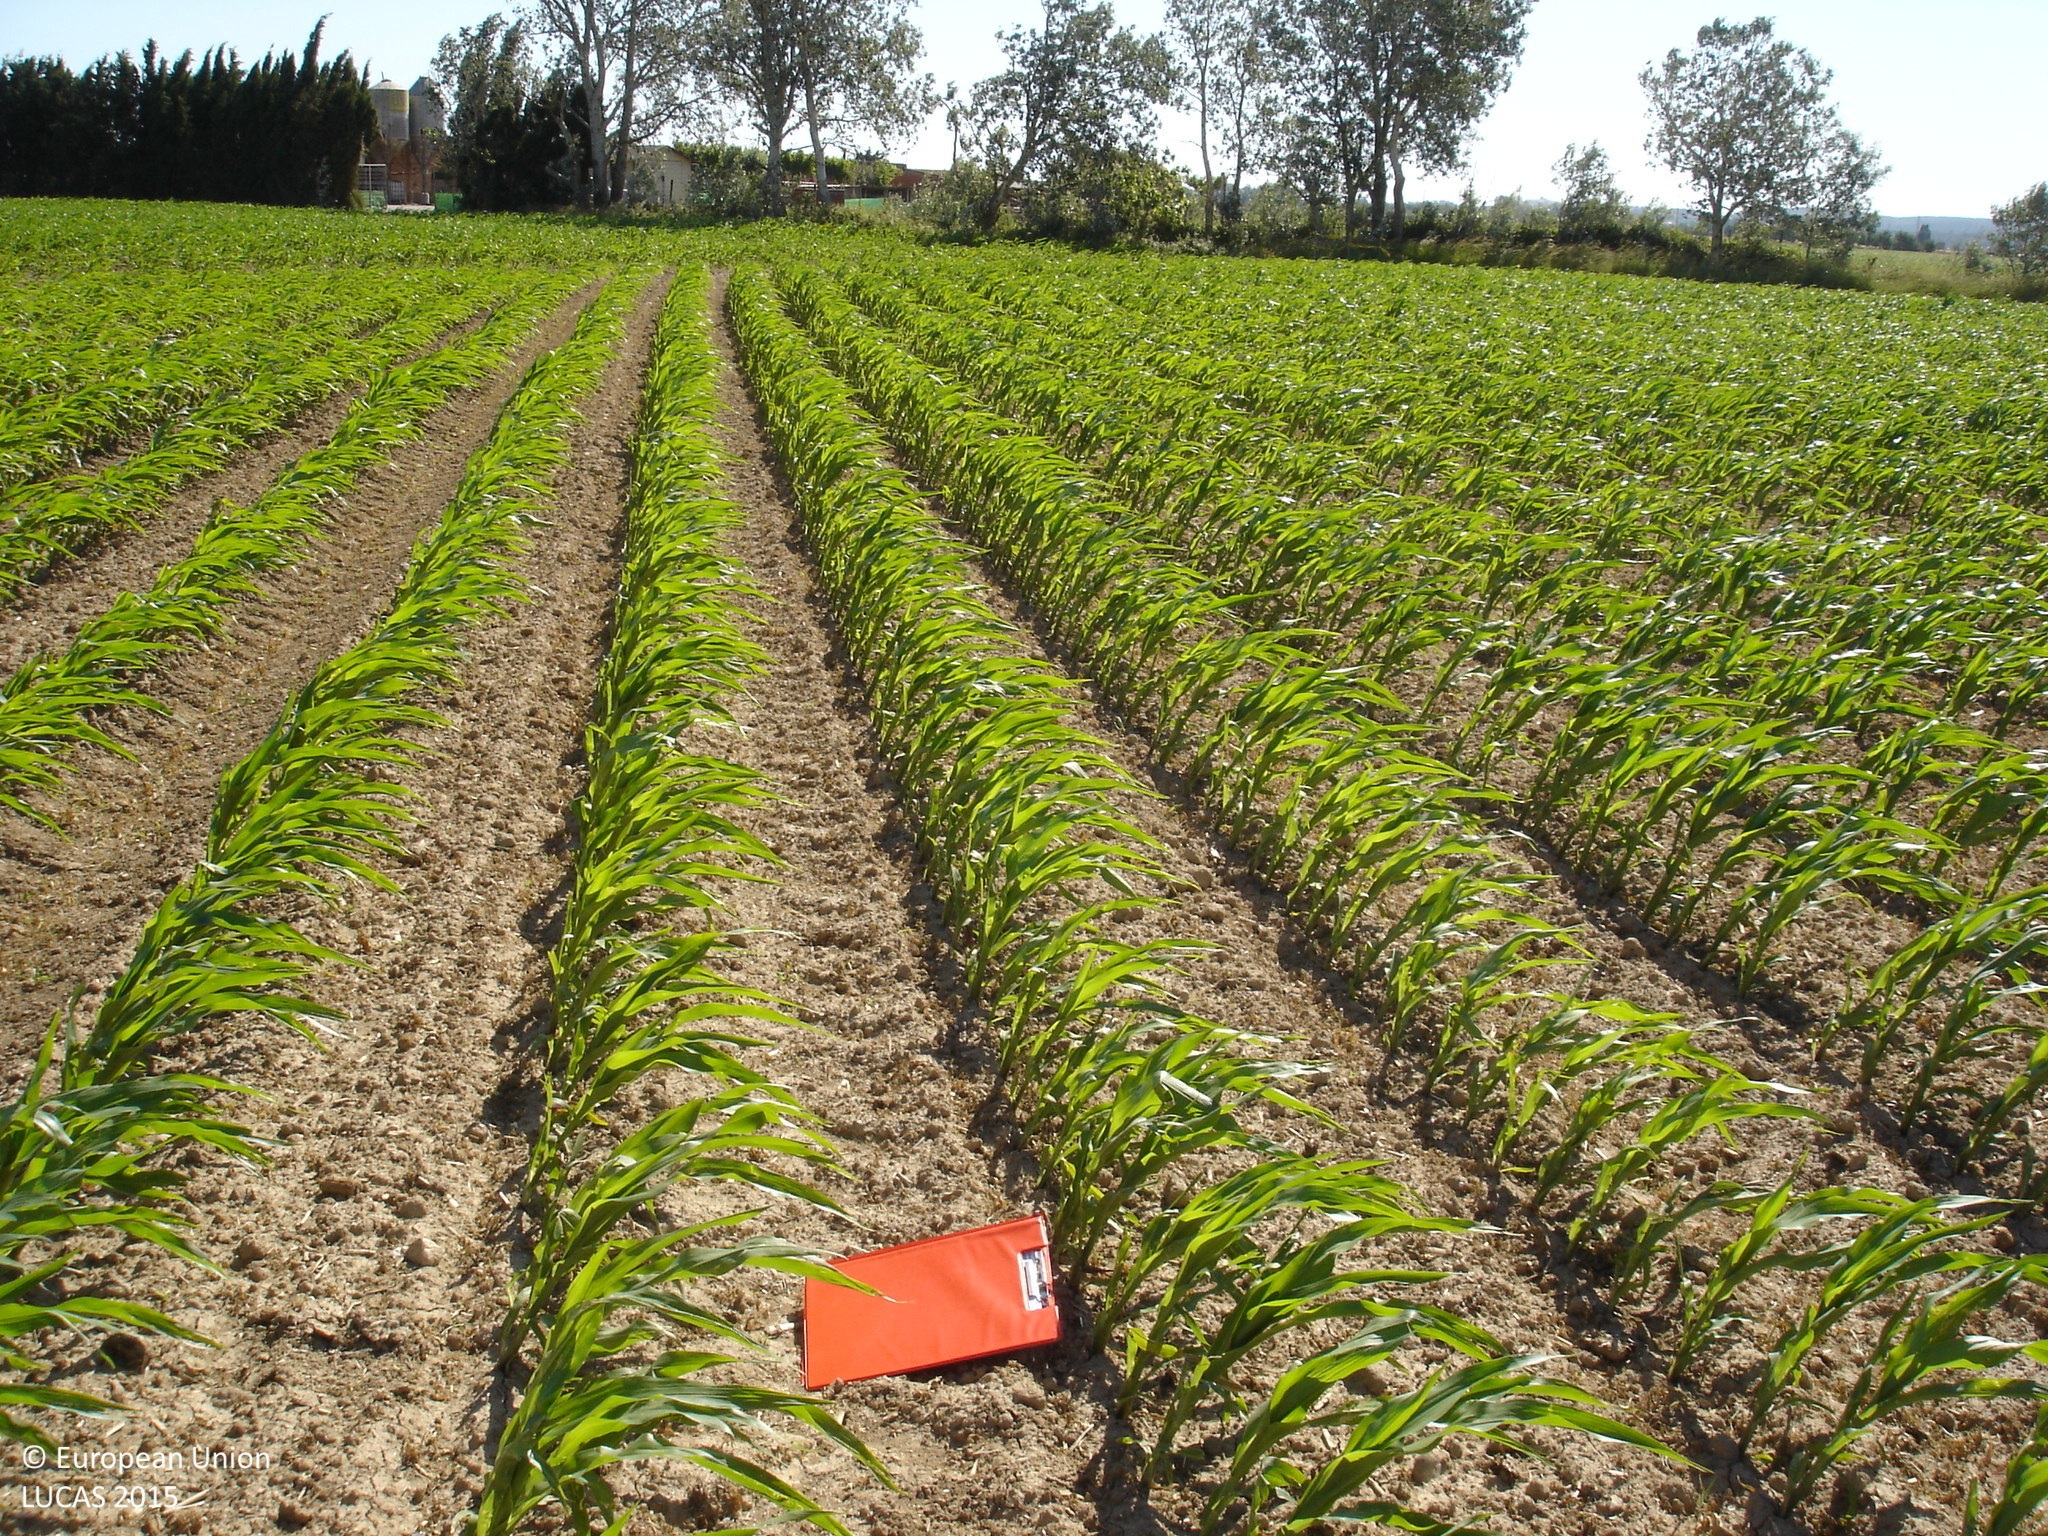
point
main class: Cropland
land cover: Maize
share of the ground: 25 - 50 %
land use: Agriculture (excluding fallow land and kitchen gardens)
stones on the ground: < 10 %
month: May
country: ES
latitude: 42.1095
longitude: 3.0856
